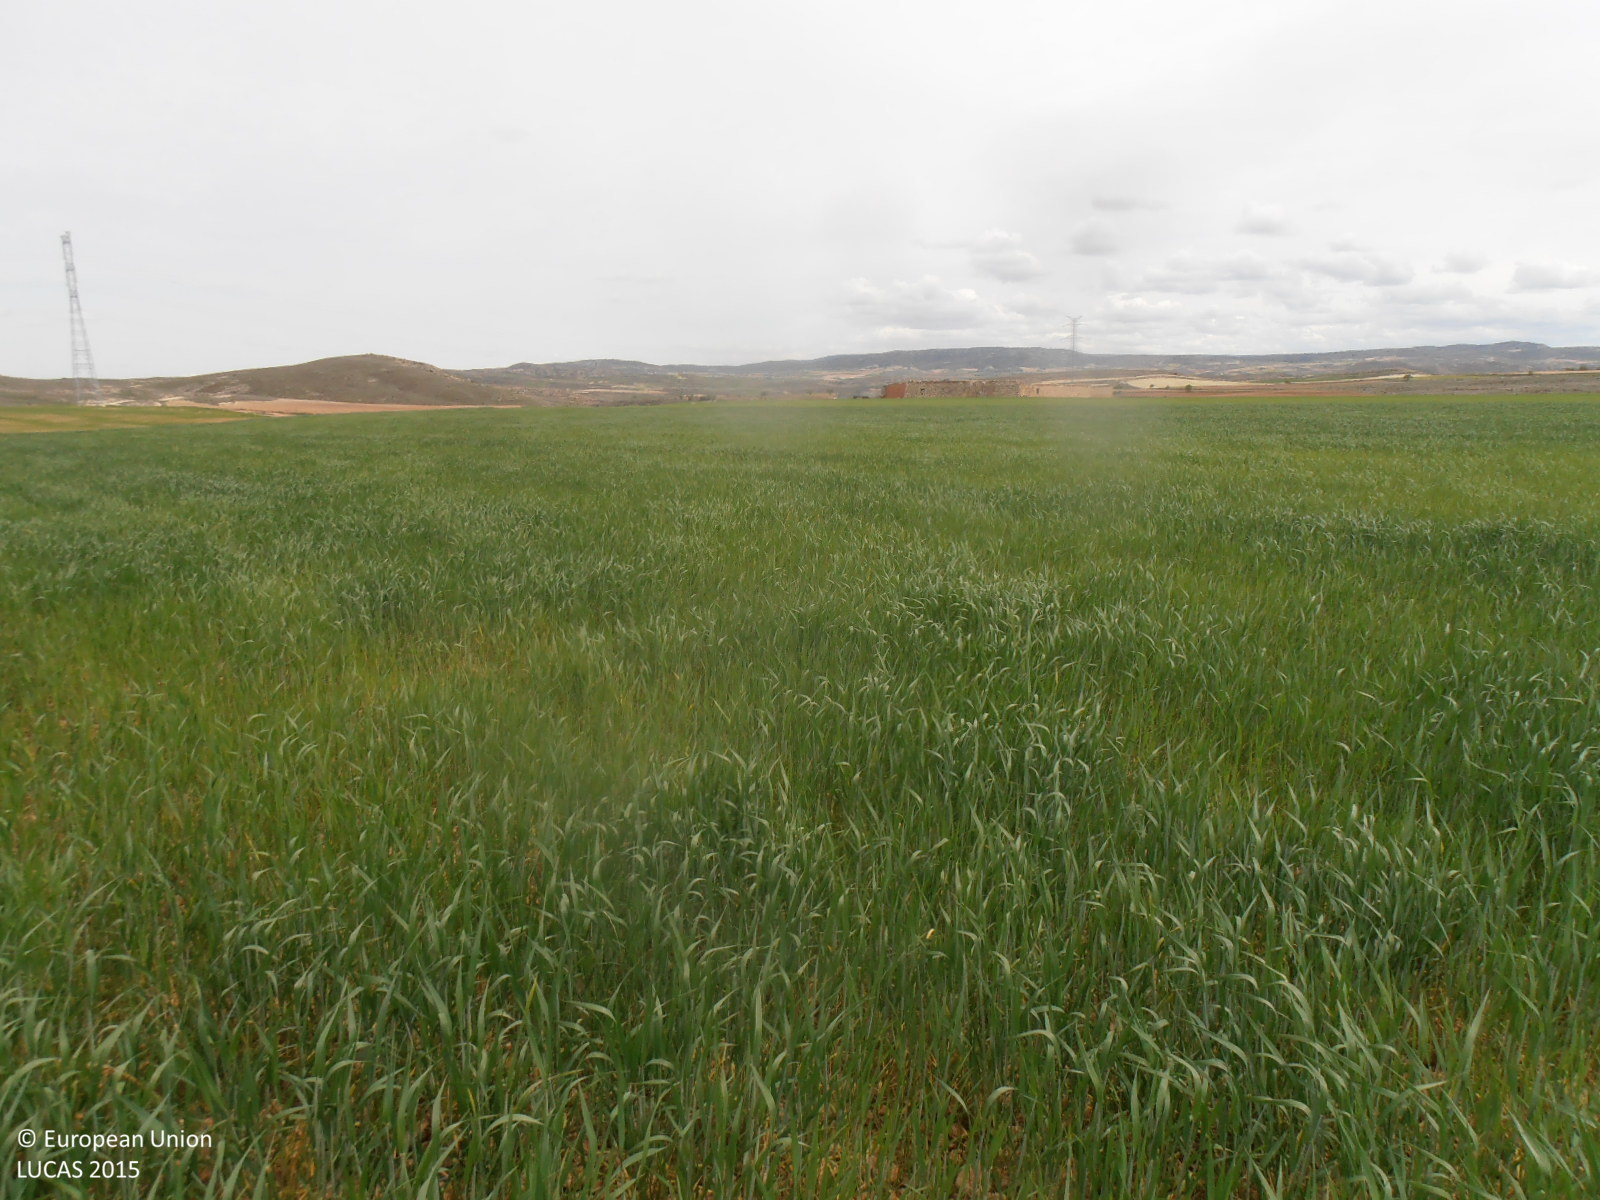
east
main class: Cropland
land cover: Durum wheat
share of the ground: > 75 %
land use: Agriculture (excluding fallow land and kitchen gardens)
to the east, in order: Durum wheat; Grass margins; Barley; Grassland without tree/shrub cover; Barley
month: April
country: ES
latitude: 41.1562
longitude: -0.8732
